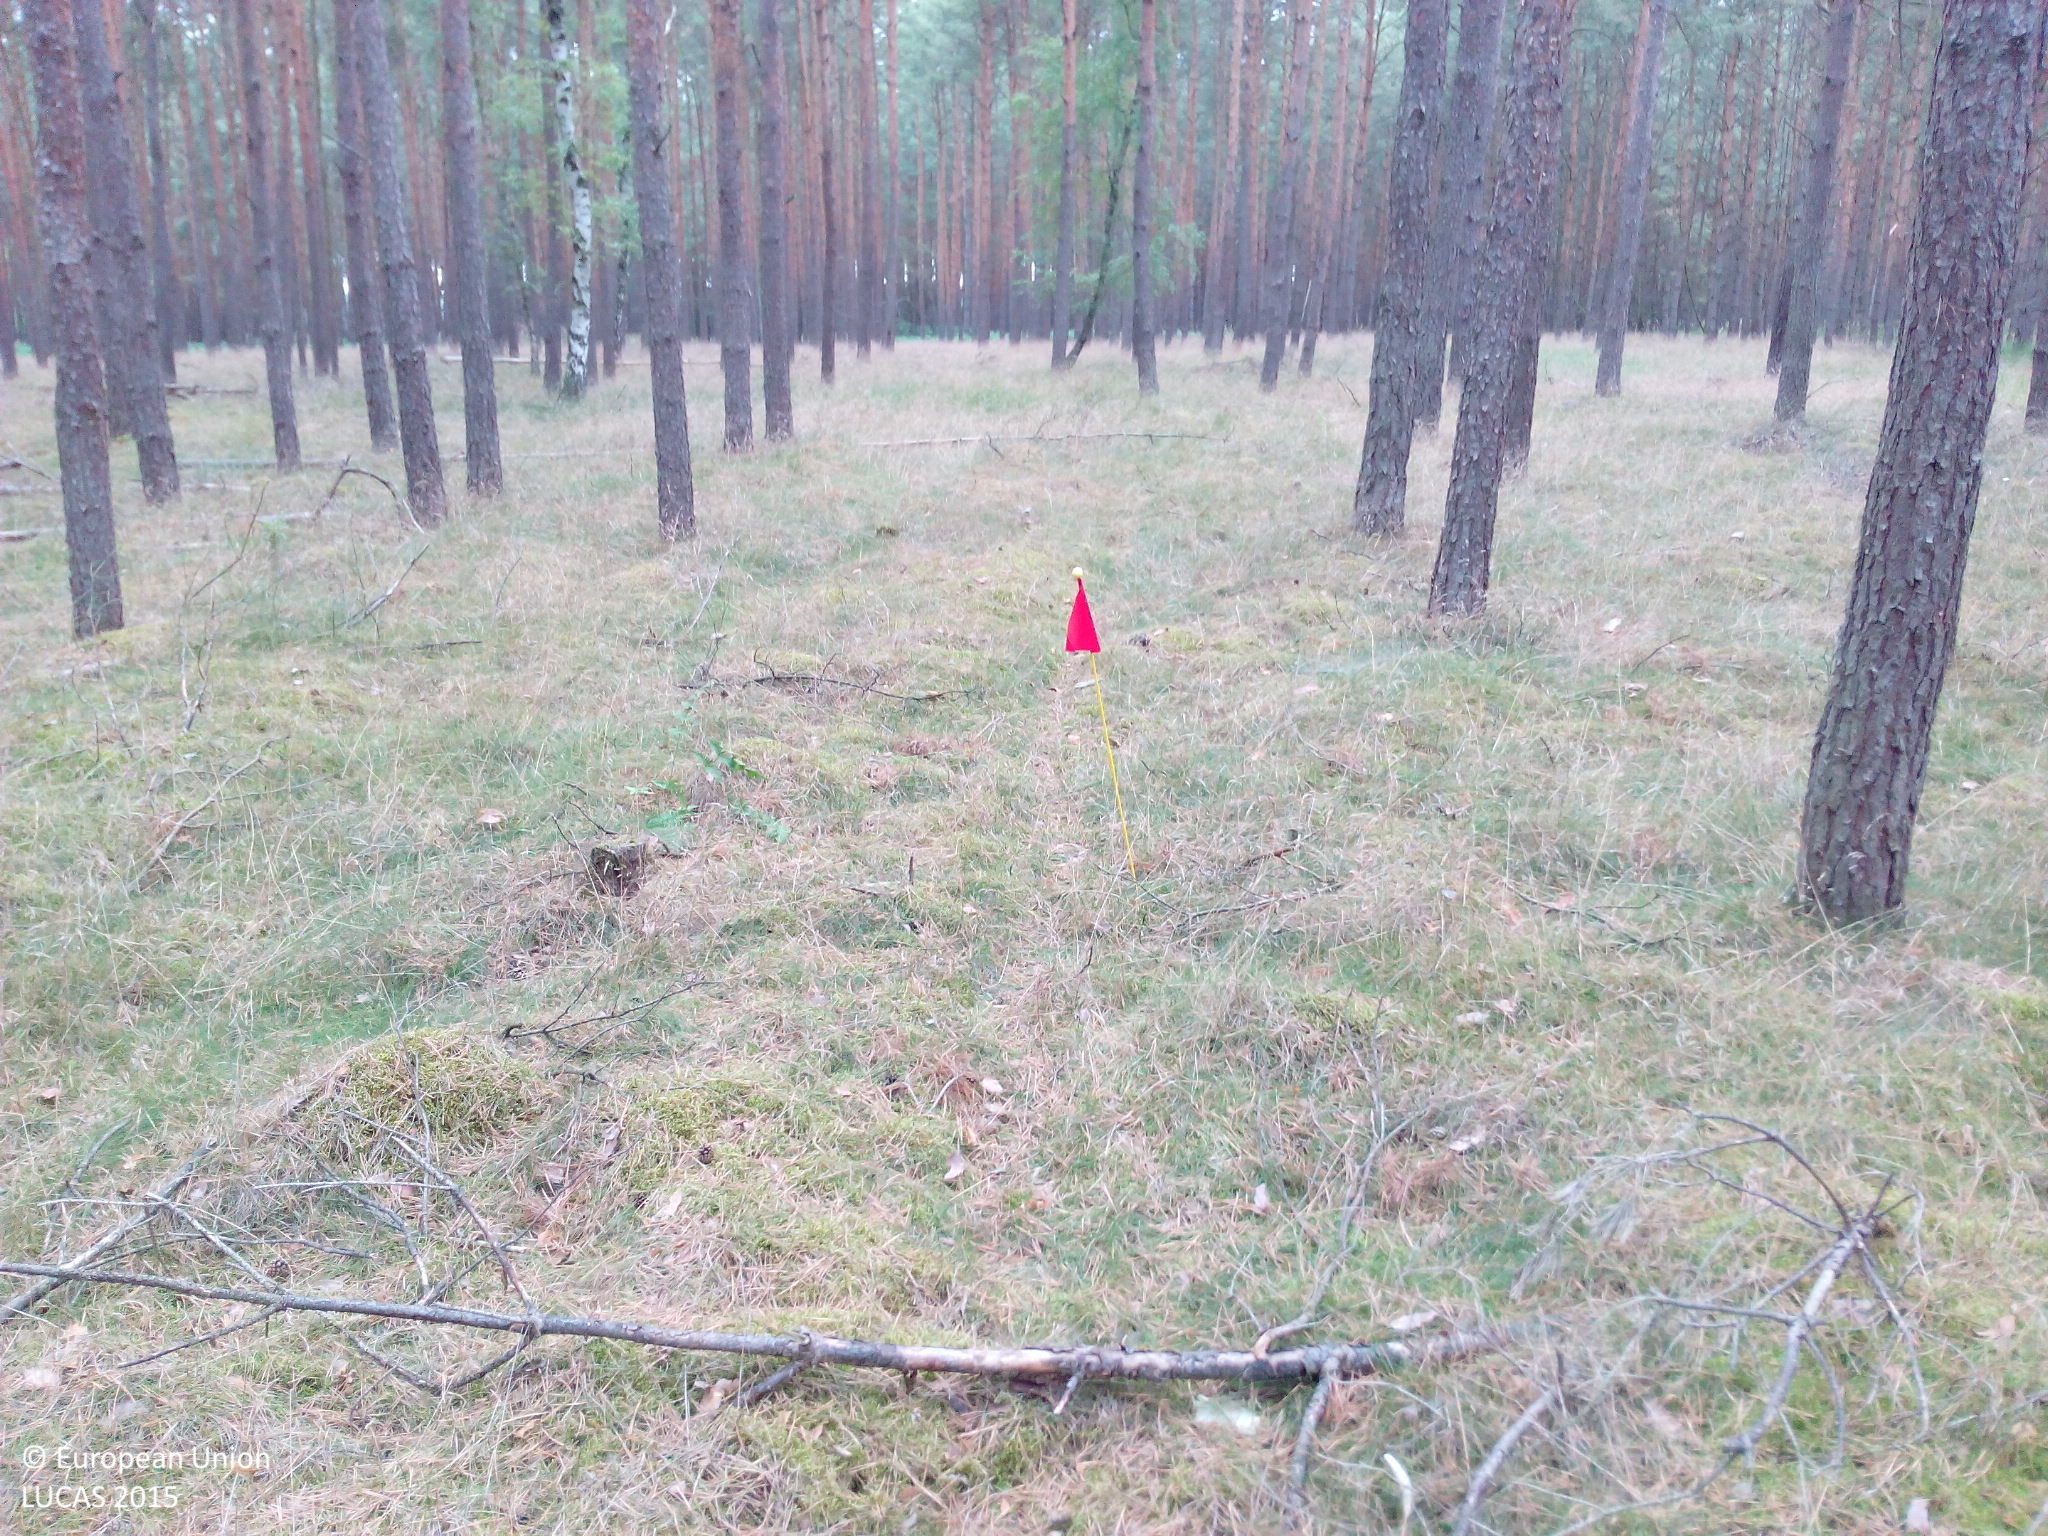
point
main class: Woodland
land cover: Pine dominated coniferous woodland
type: hemiboreal forest and nemoral coniferous forest and mixed broadleaved-coniferous forest
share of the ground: 50 - 75 %
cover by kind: coniferous forest trees 60 %, herbaceous plants 20 %, lichens and mosses 20 %
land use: Forestry
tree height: > 5 m
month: July
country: DE
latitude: 52.5190
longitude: 12.1954
